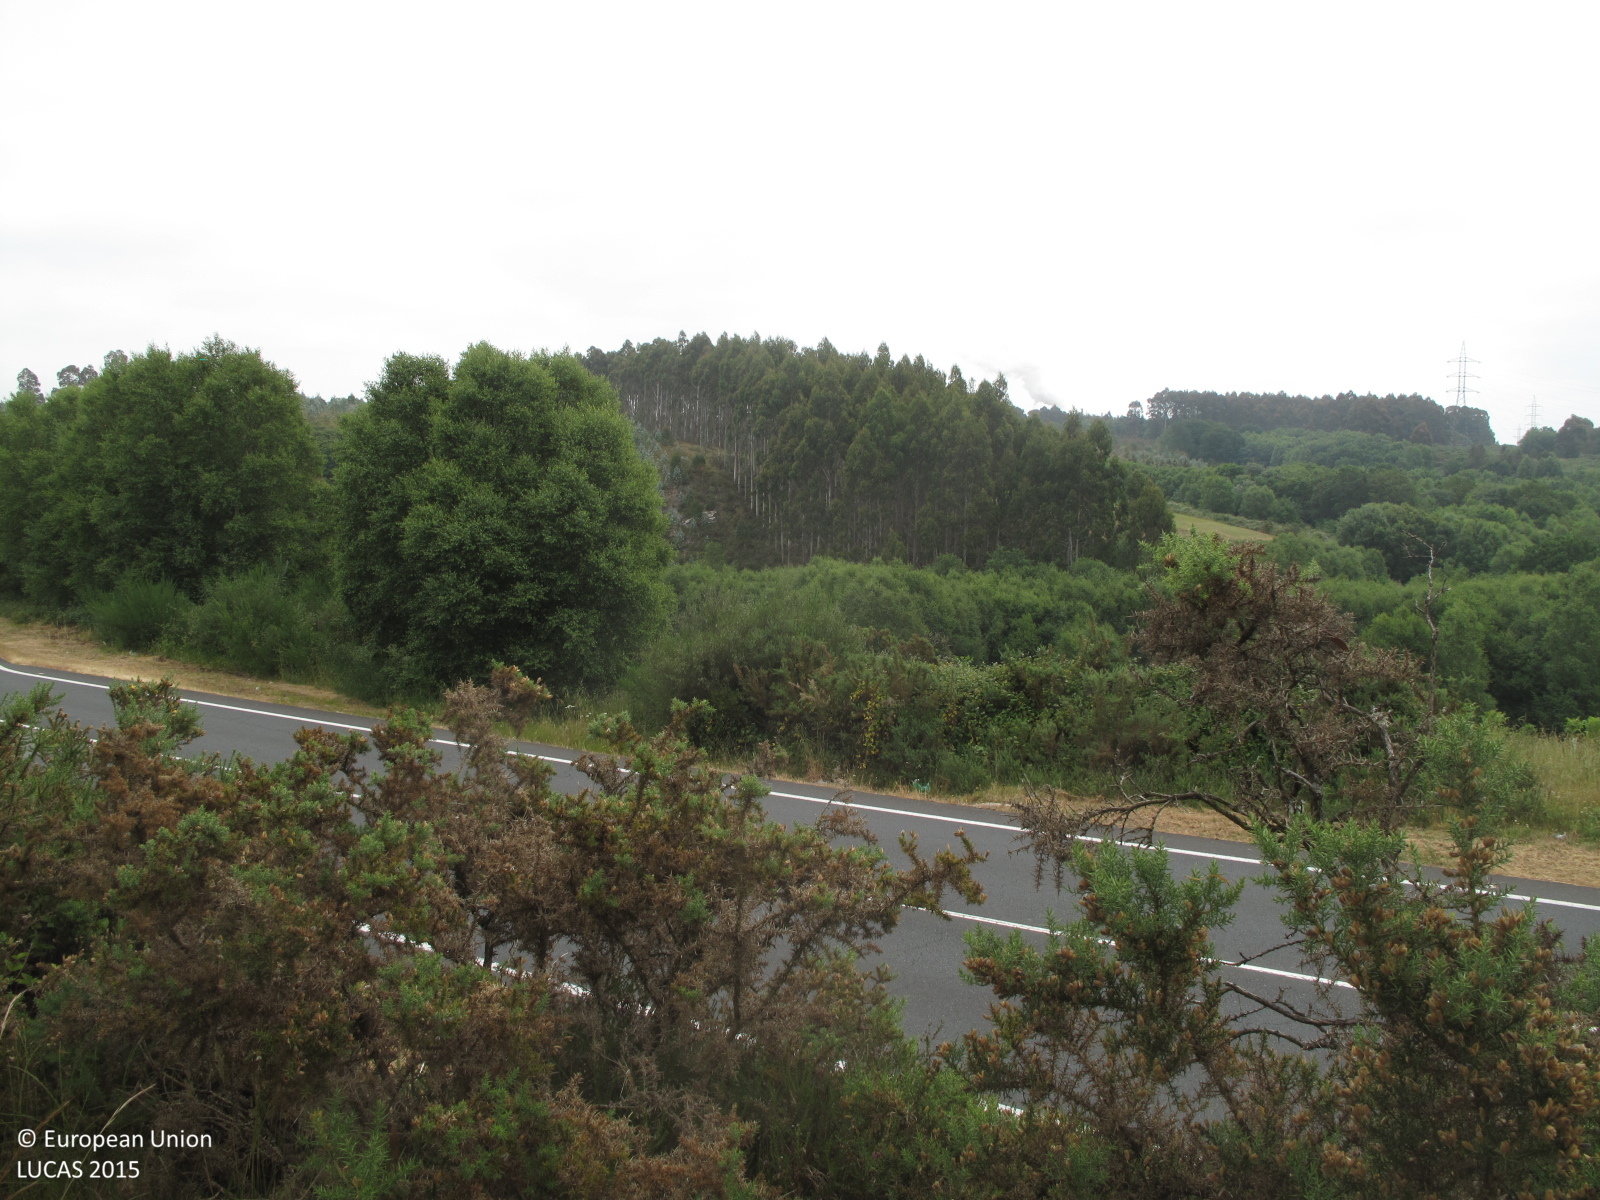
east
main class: Woodland
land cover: Broadleaved woodland
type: exotic forest
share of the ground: 25 - 50 %
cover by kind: herbaceous plants 50 %, broadleaved forest trees 40 %, shrubs 10 %
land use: Forestry
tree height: < 5 m
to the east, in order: Broadleaved woodland; Paved roads, cycling and walking lanes; Broadleaved woodland; Pine dominated mixed woodland; Broadleaved woodland; Shrubland with sparse tree cover; Broadleaved woodland; Shrubland without tree cover
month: June
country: ES
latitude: 43.1597
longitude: -8.0367
